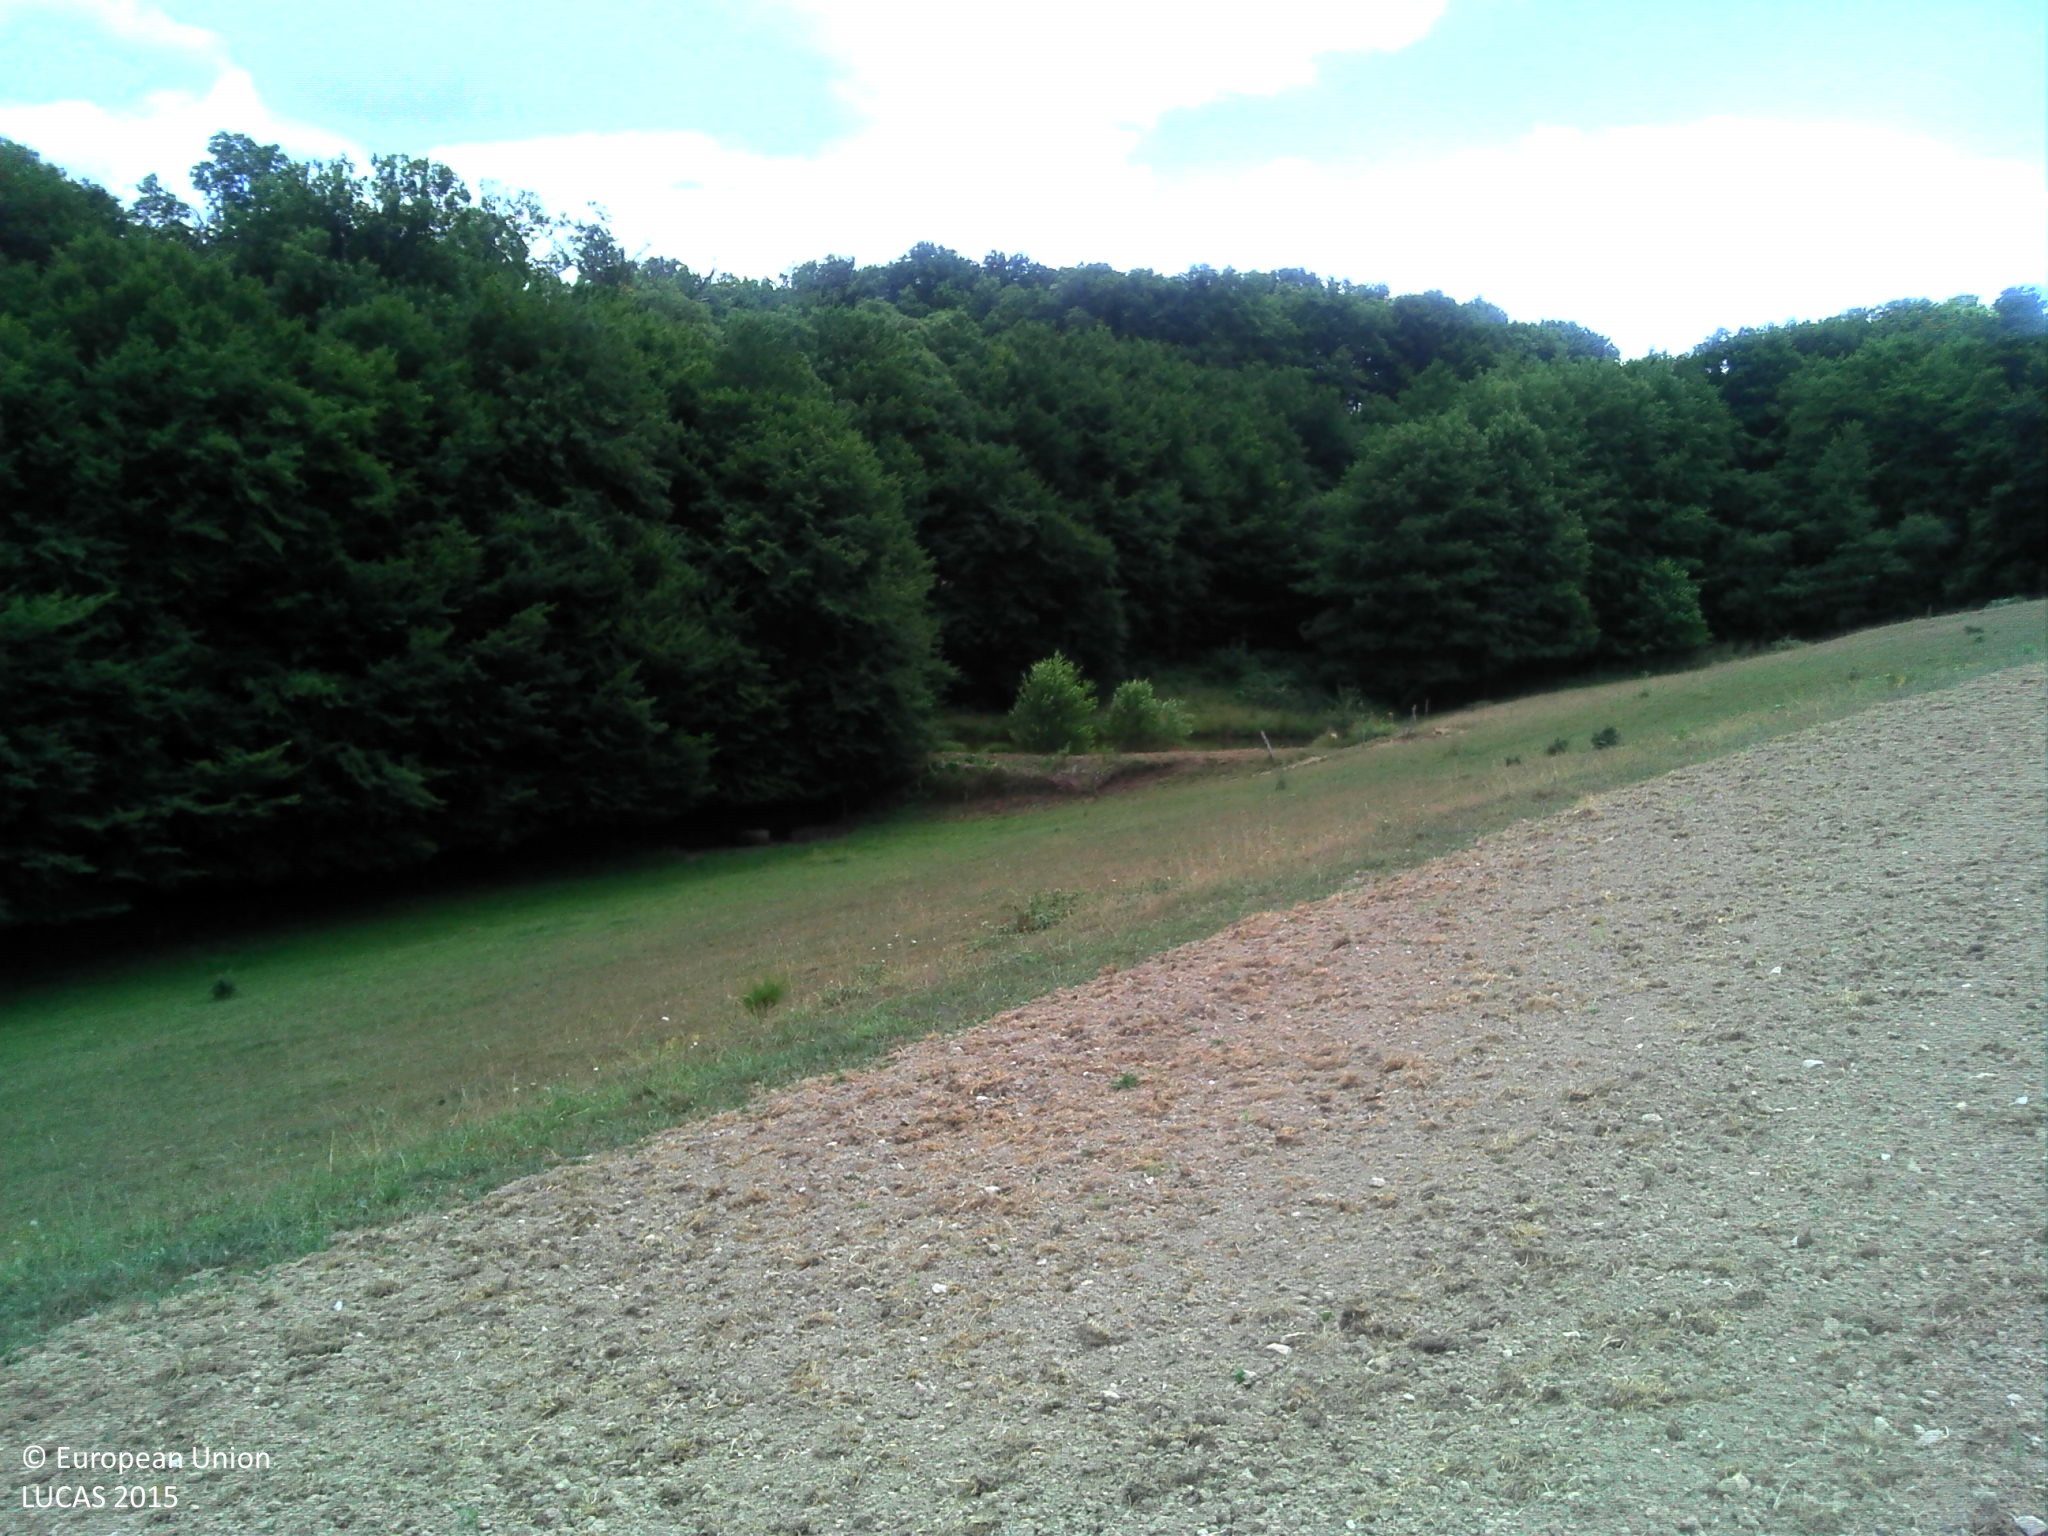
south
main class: Cropland
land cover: Other cereals
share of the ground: < 10 %
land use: Agriculture (excluding fallow land and kitchen gardens)
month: July
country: FR
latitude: 46.3848
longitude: 1.6301
